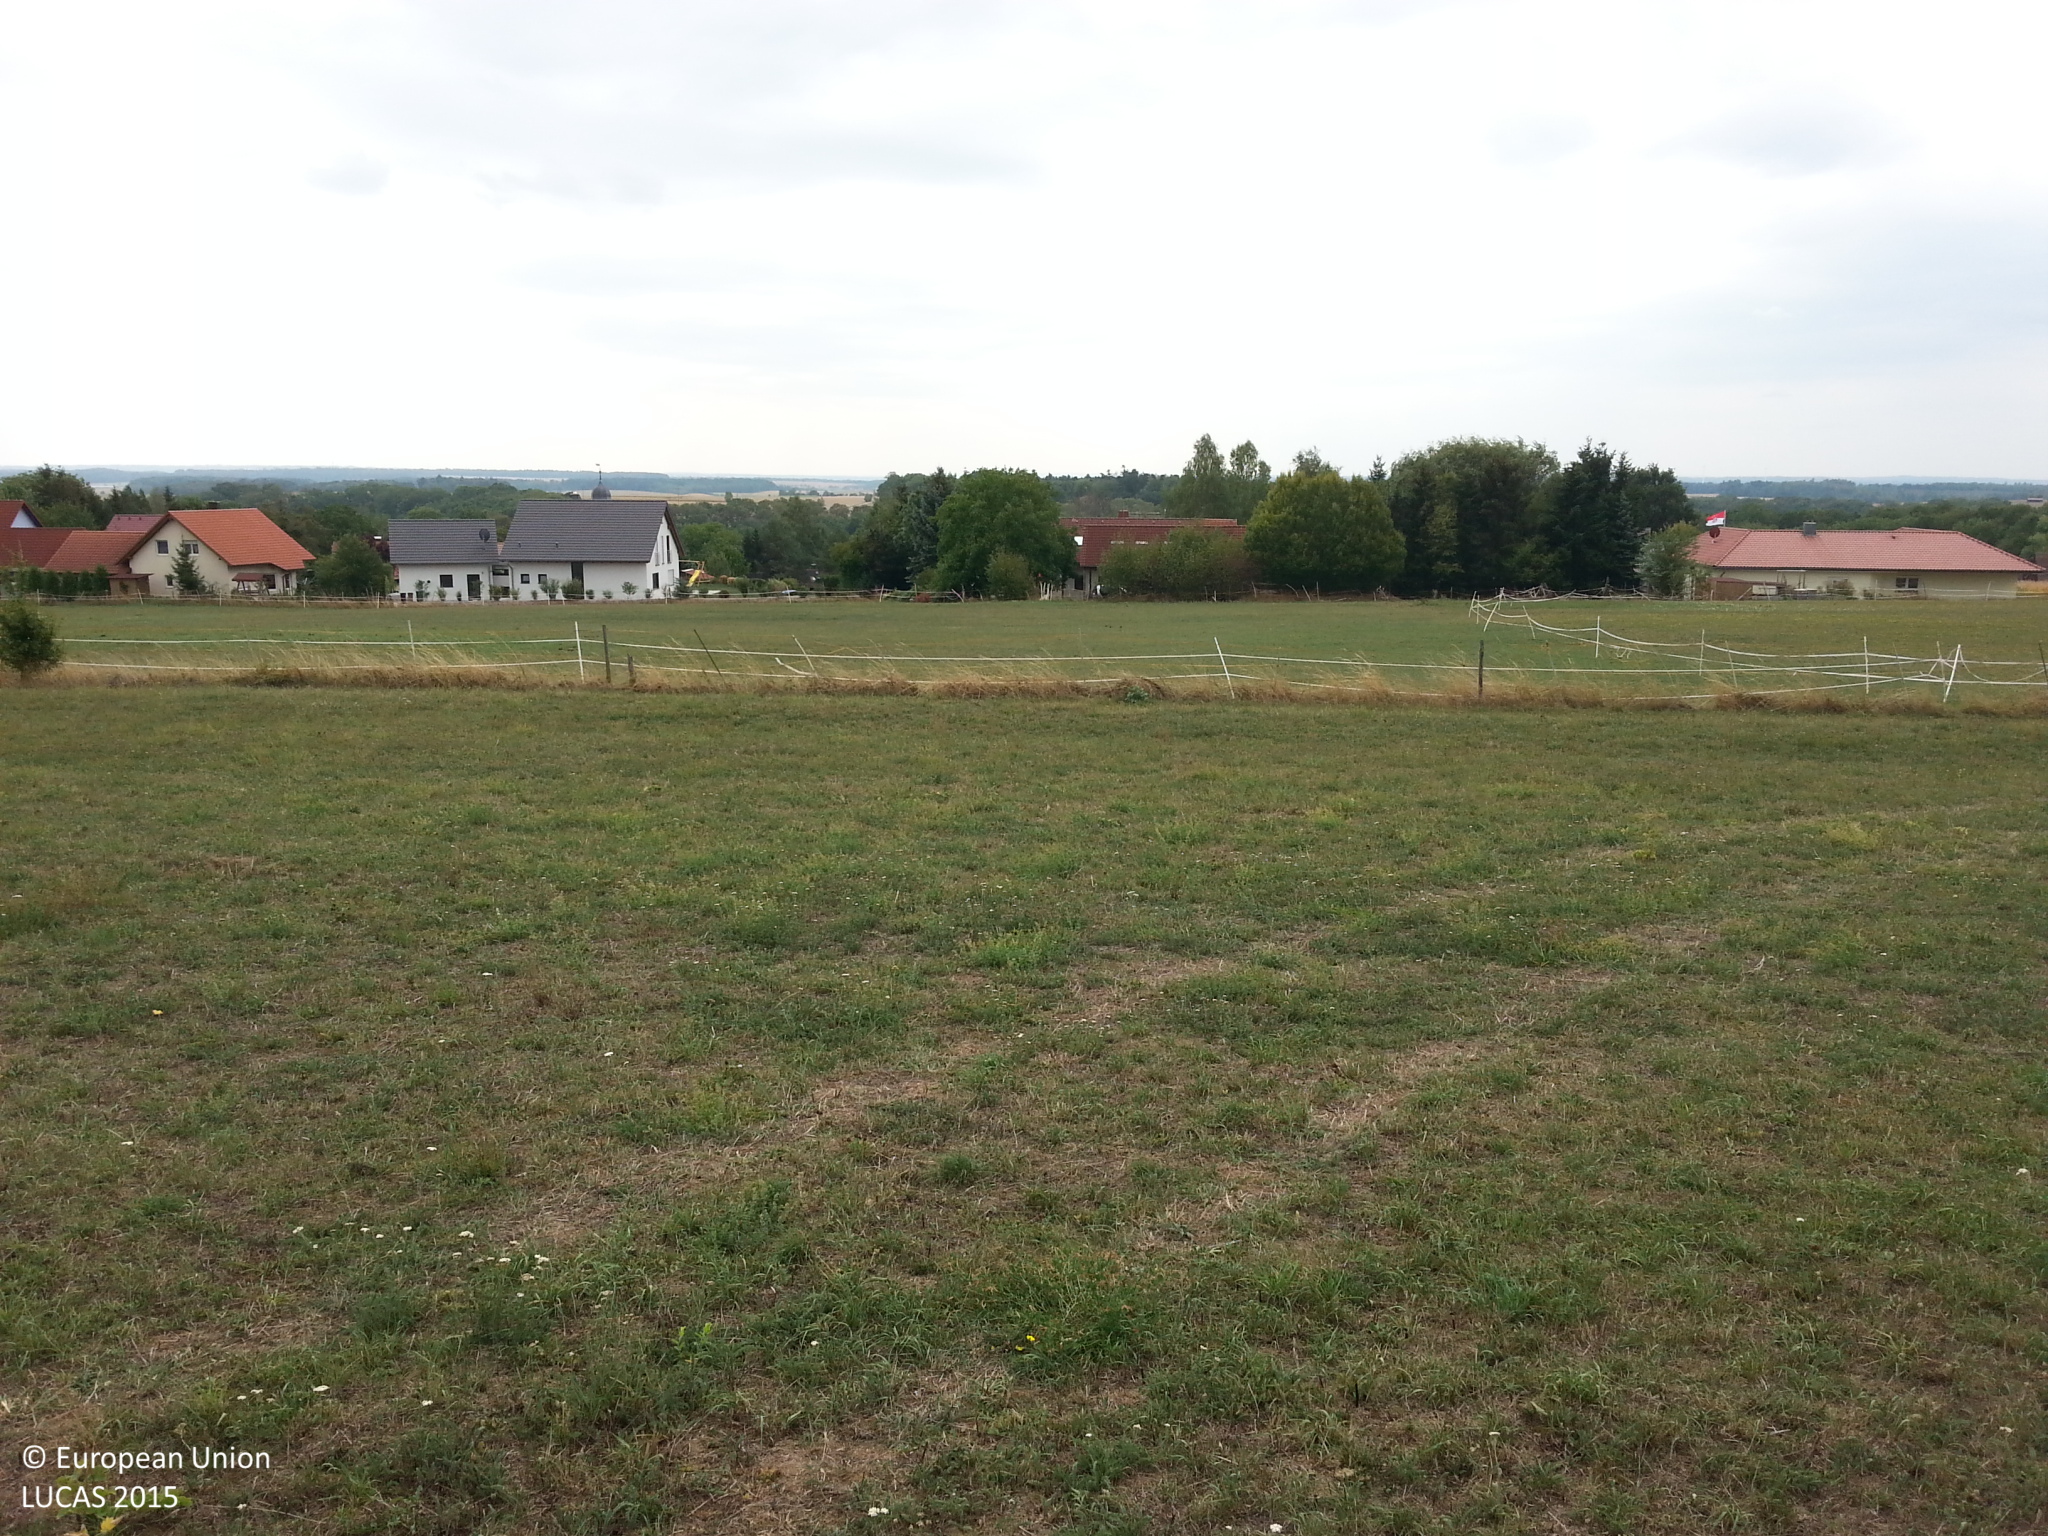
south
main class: Grassland
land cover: Grassland without tree/shrub cover
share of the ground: > 75 %
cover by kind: herbaceous plants 90 %, unconsolidated bare surface 10 %
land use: Agriculture (excluding fallow land and kitchen gardens)
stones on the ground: < 10 %
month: September
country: DE
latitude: 49.2670
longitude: 9.9588
